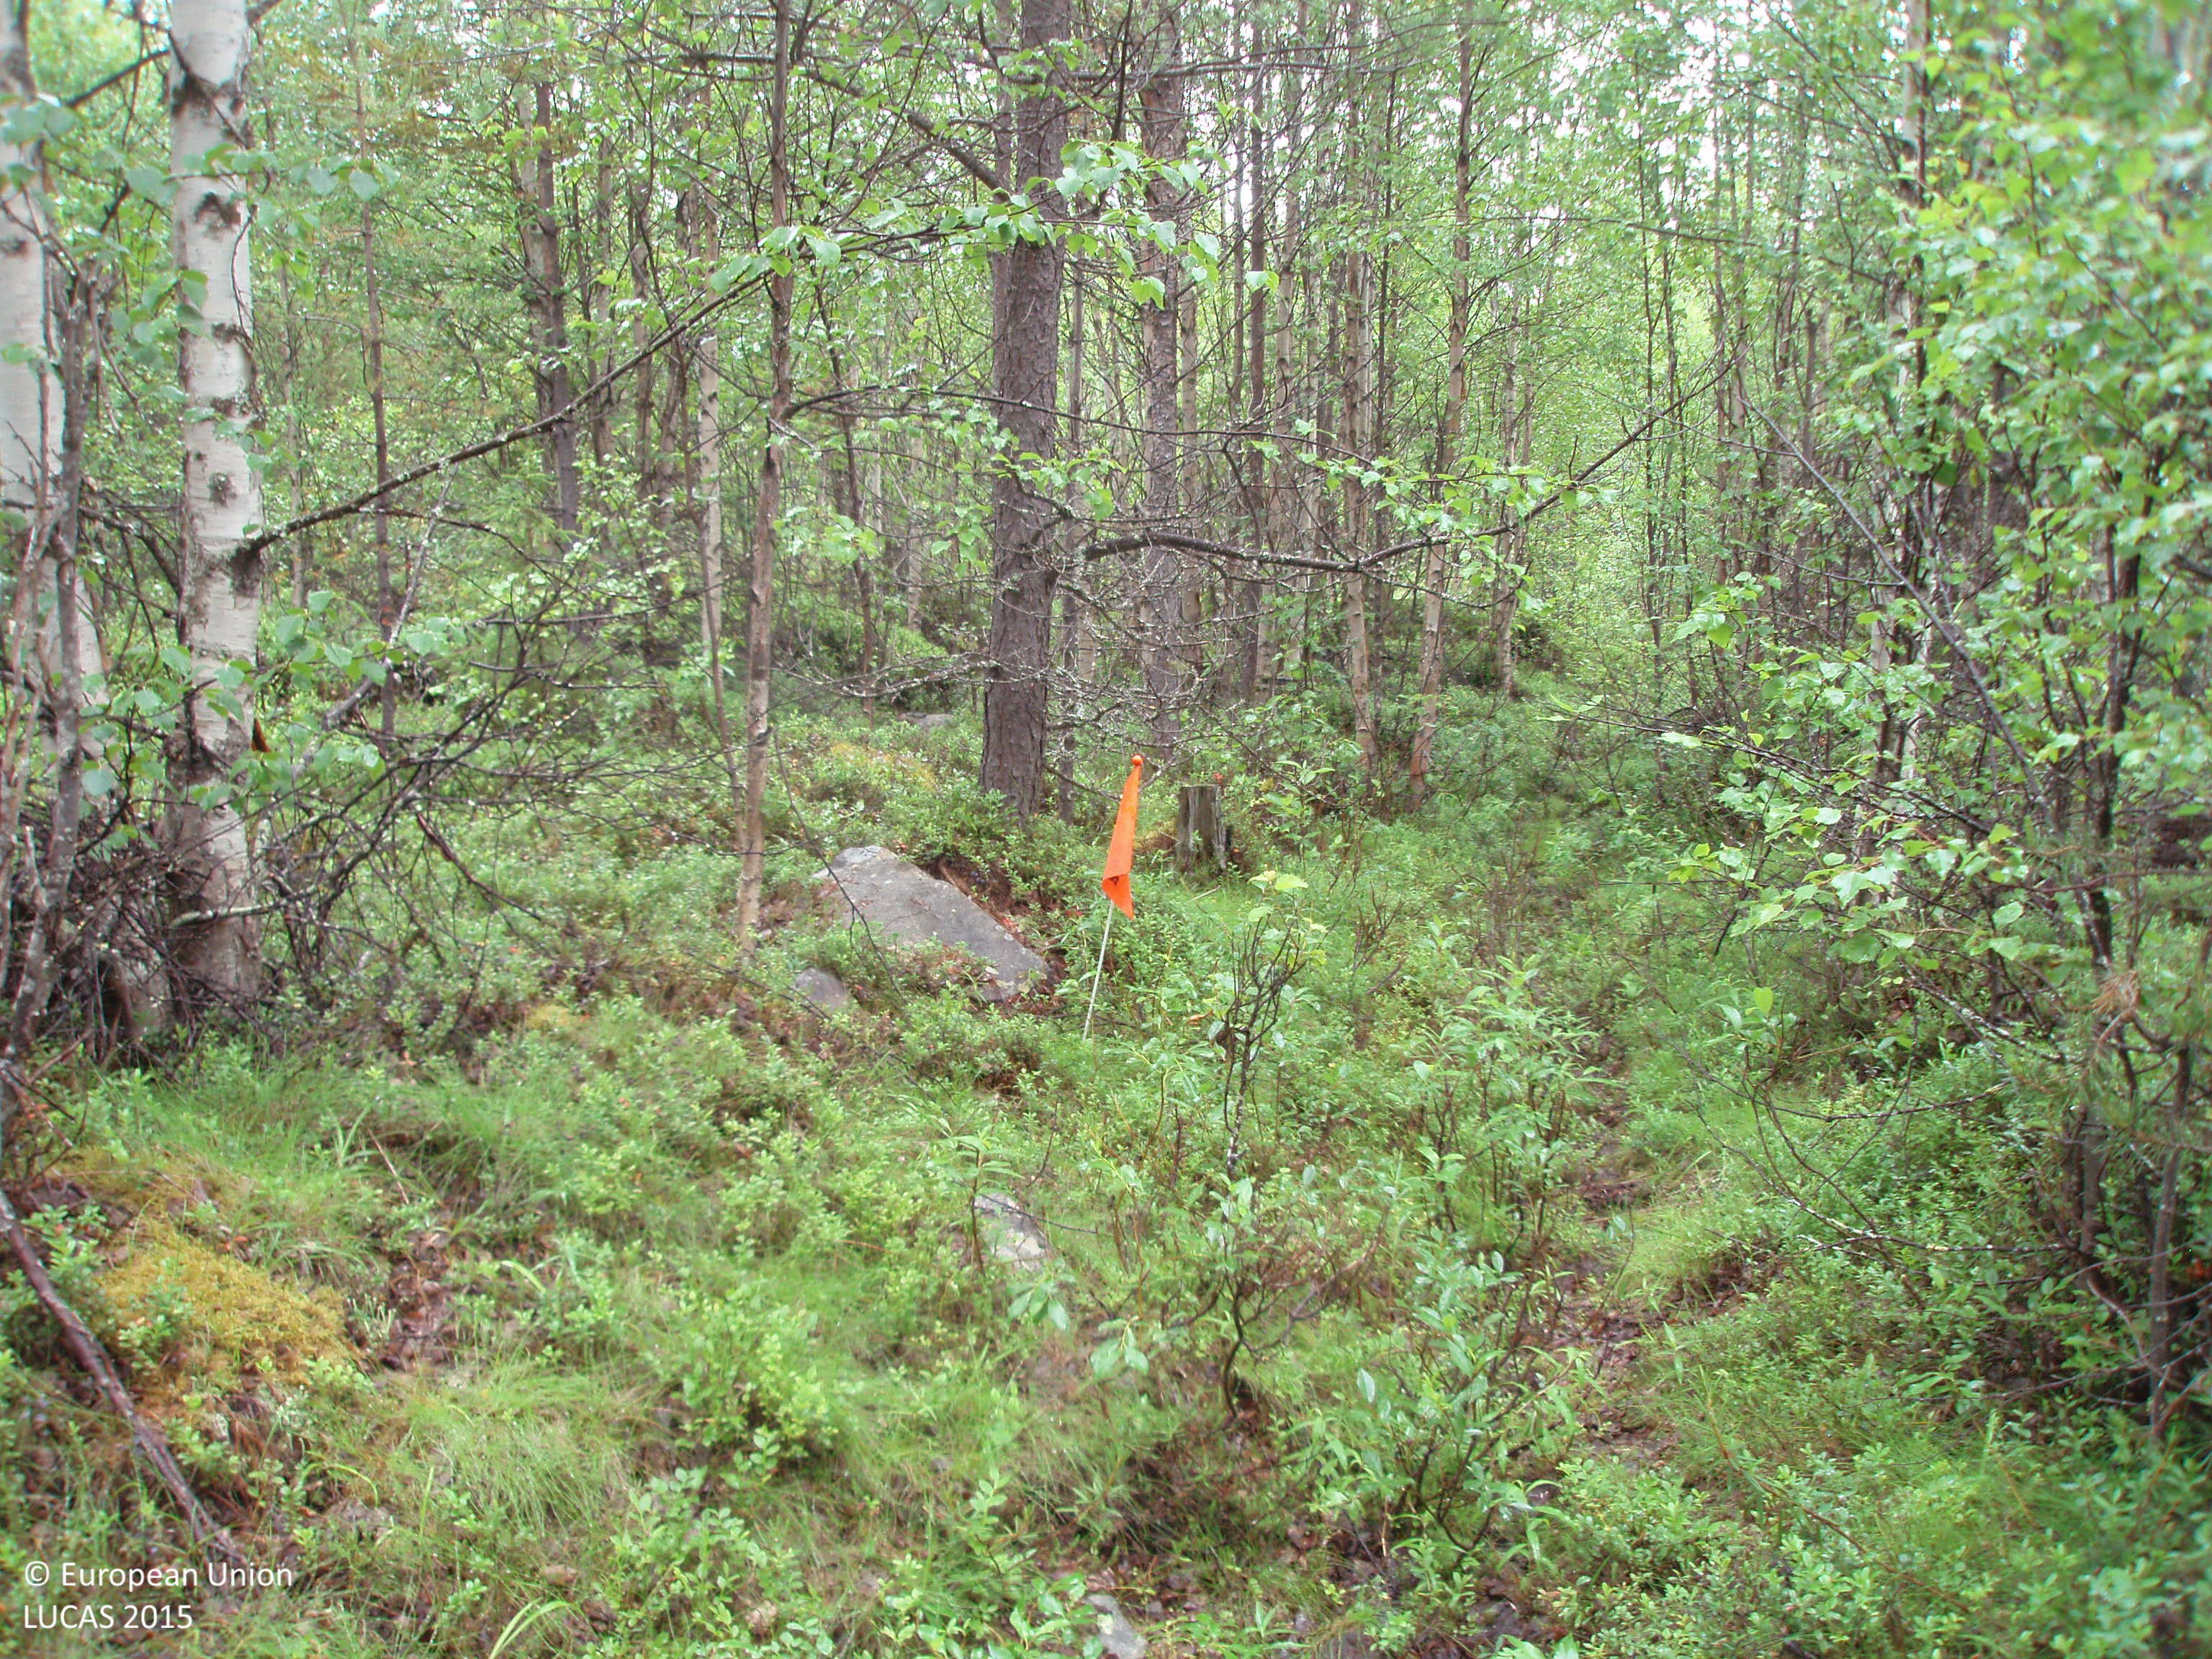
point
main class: Woodland
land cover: Pine dominated mixed woodland
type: boreal forest
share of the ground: > 75 %
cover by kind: broadleaved forest trees 50 %, coniferous forest trees 40 %, shrubs 10 %
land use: Forestry
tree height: > 5 m
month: July
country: FI
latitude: 66.8000
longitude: 28.2630
